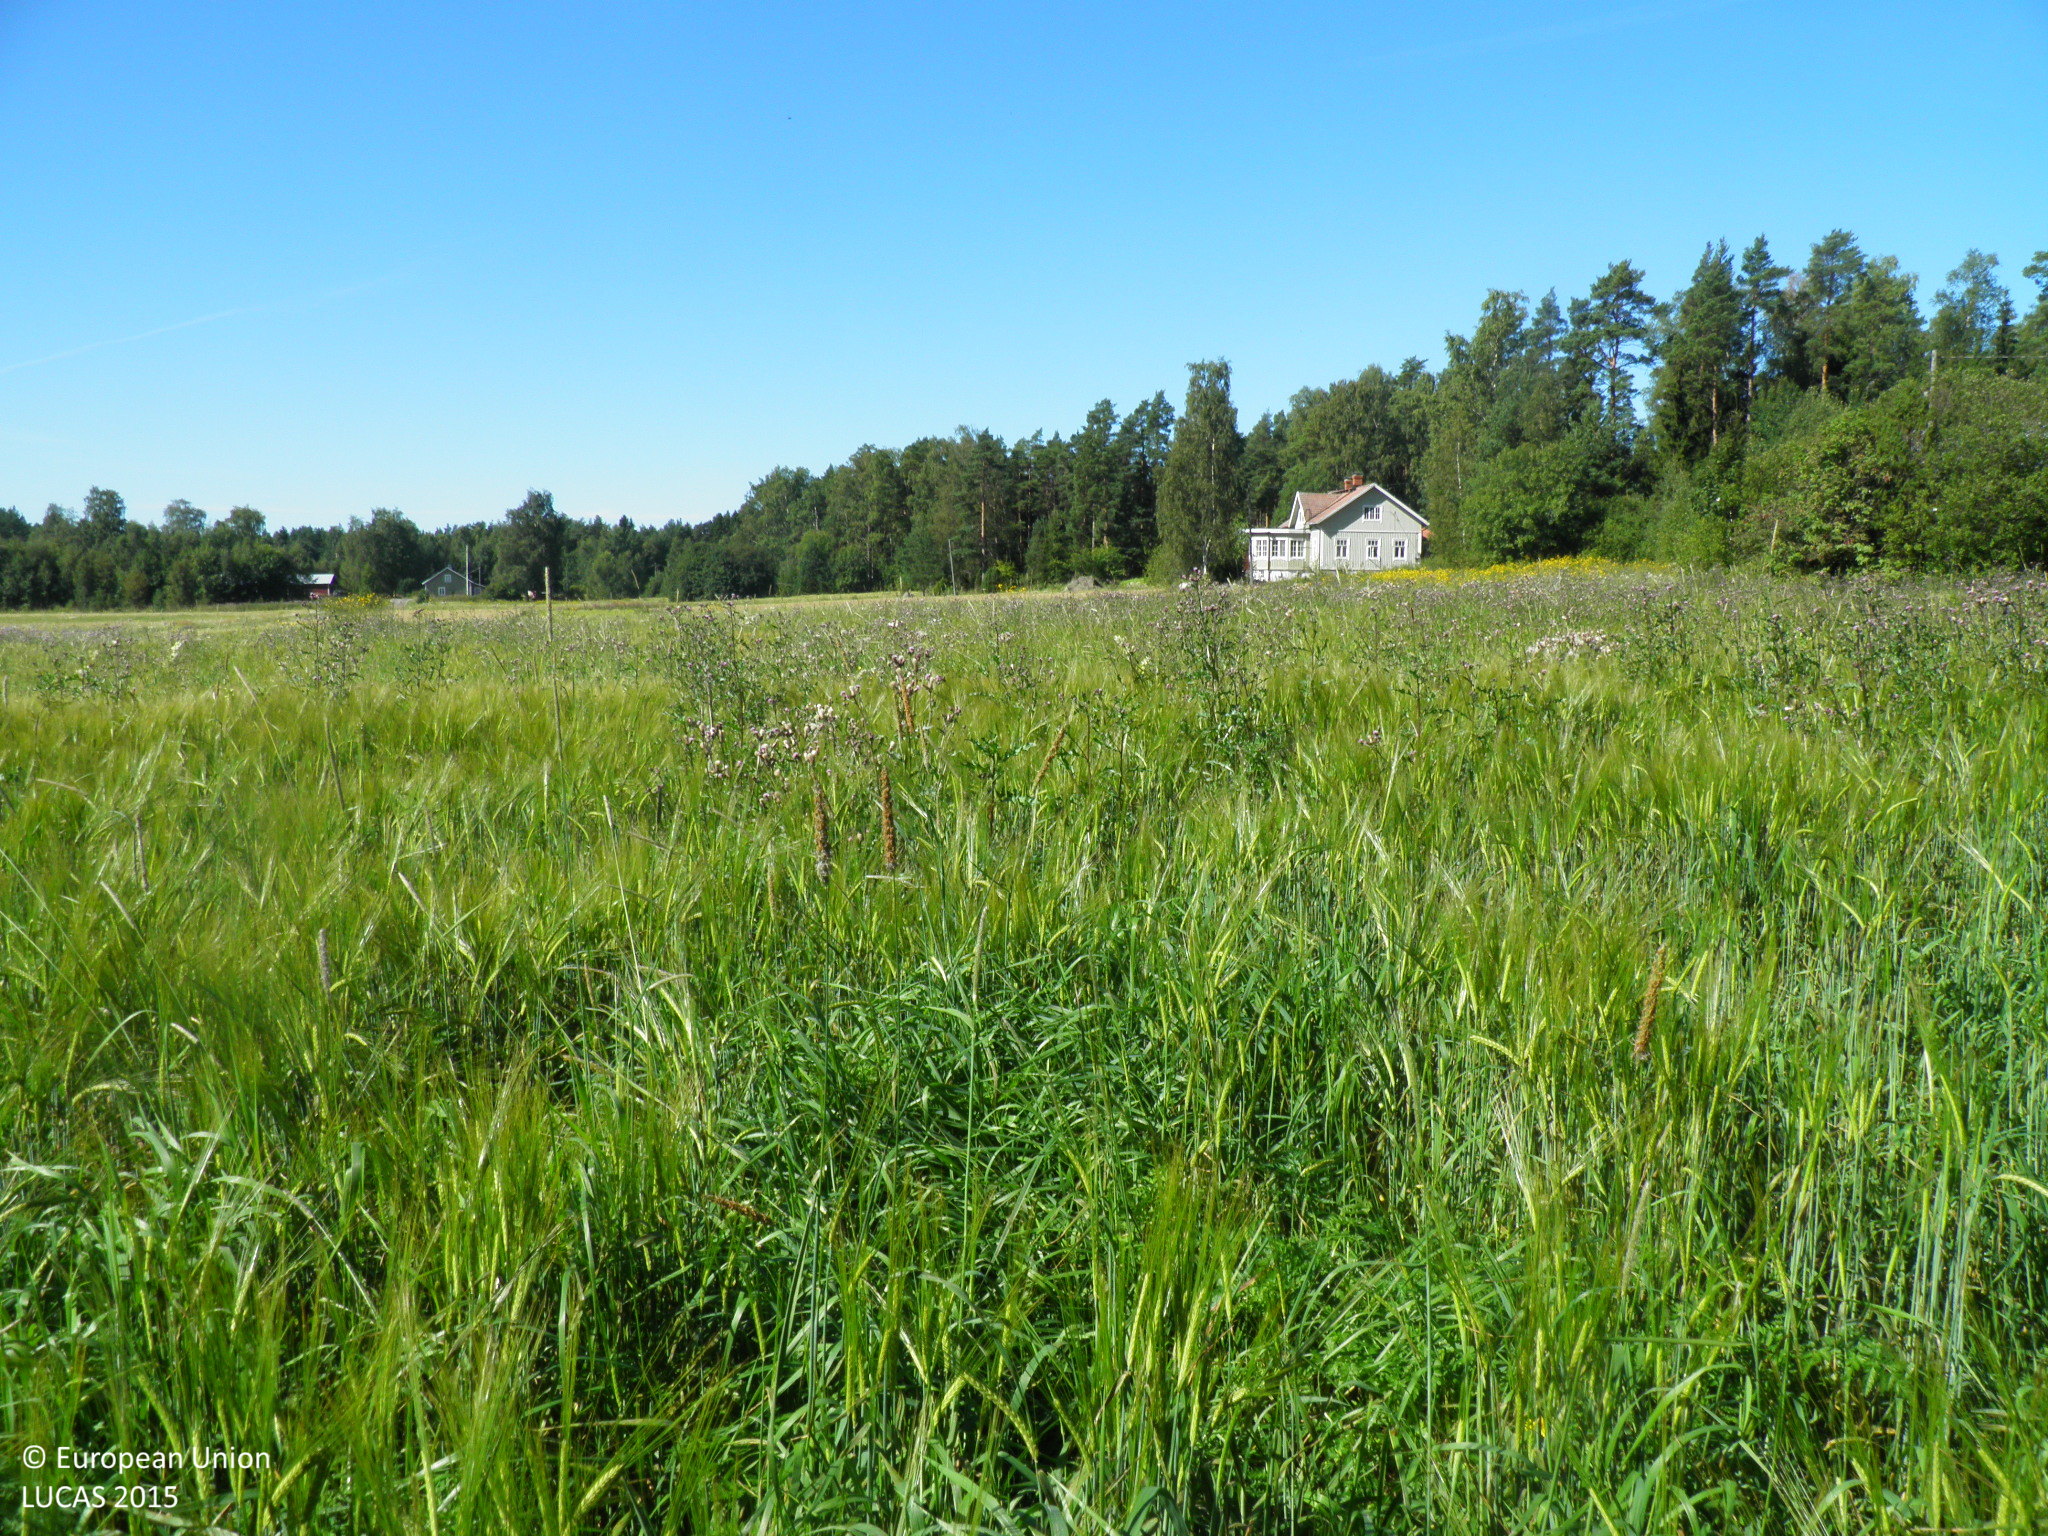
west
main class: Cropland
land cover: Barley
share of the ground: > 75 %
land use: Agriculture (excluding fallow land and kitchen gardens)
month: August
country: FI
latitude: 60.9610
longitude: 21.3361
